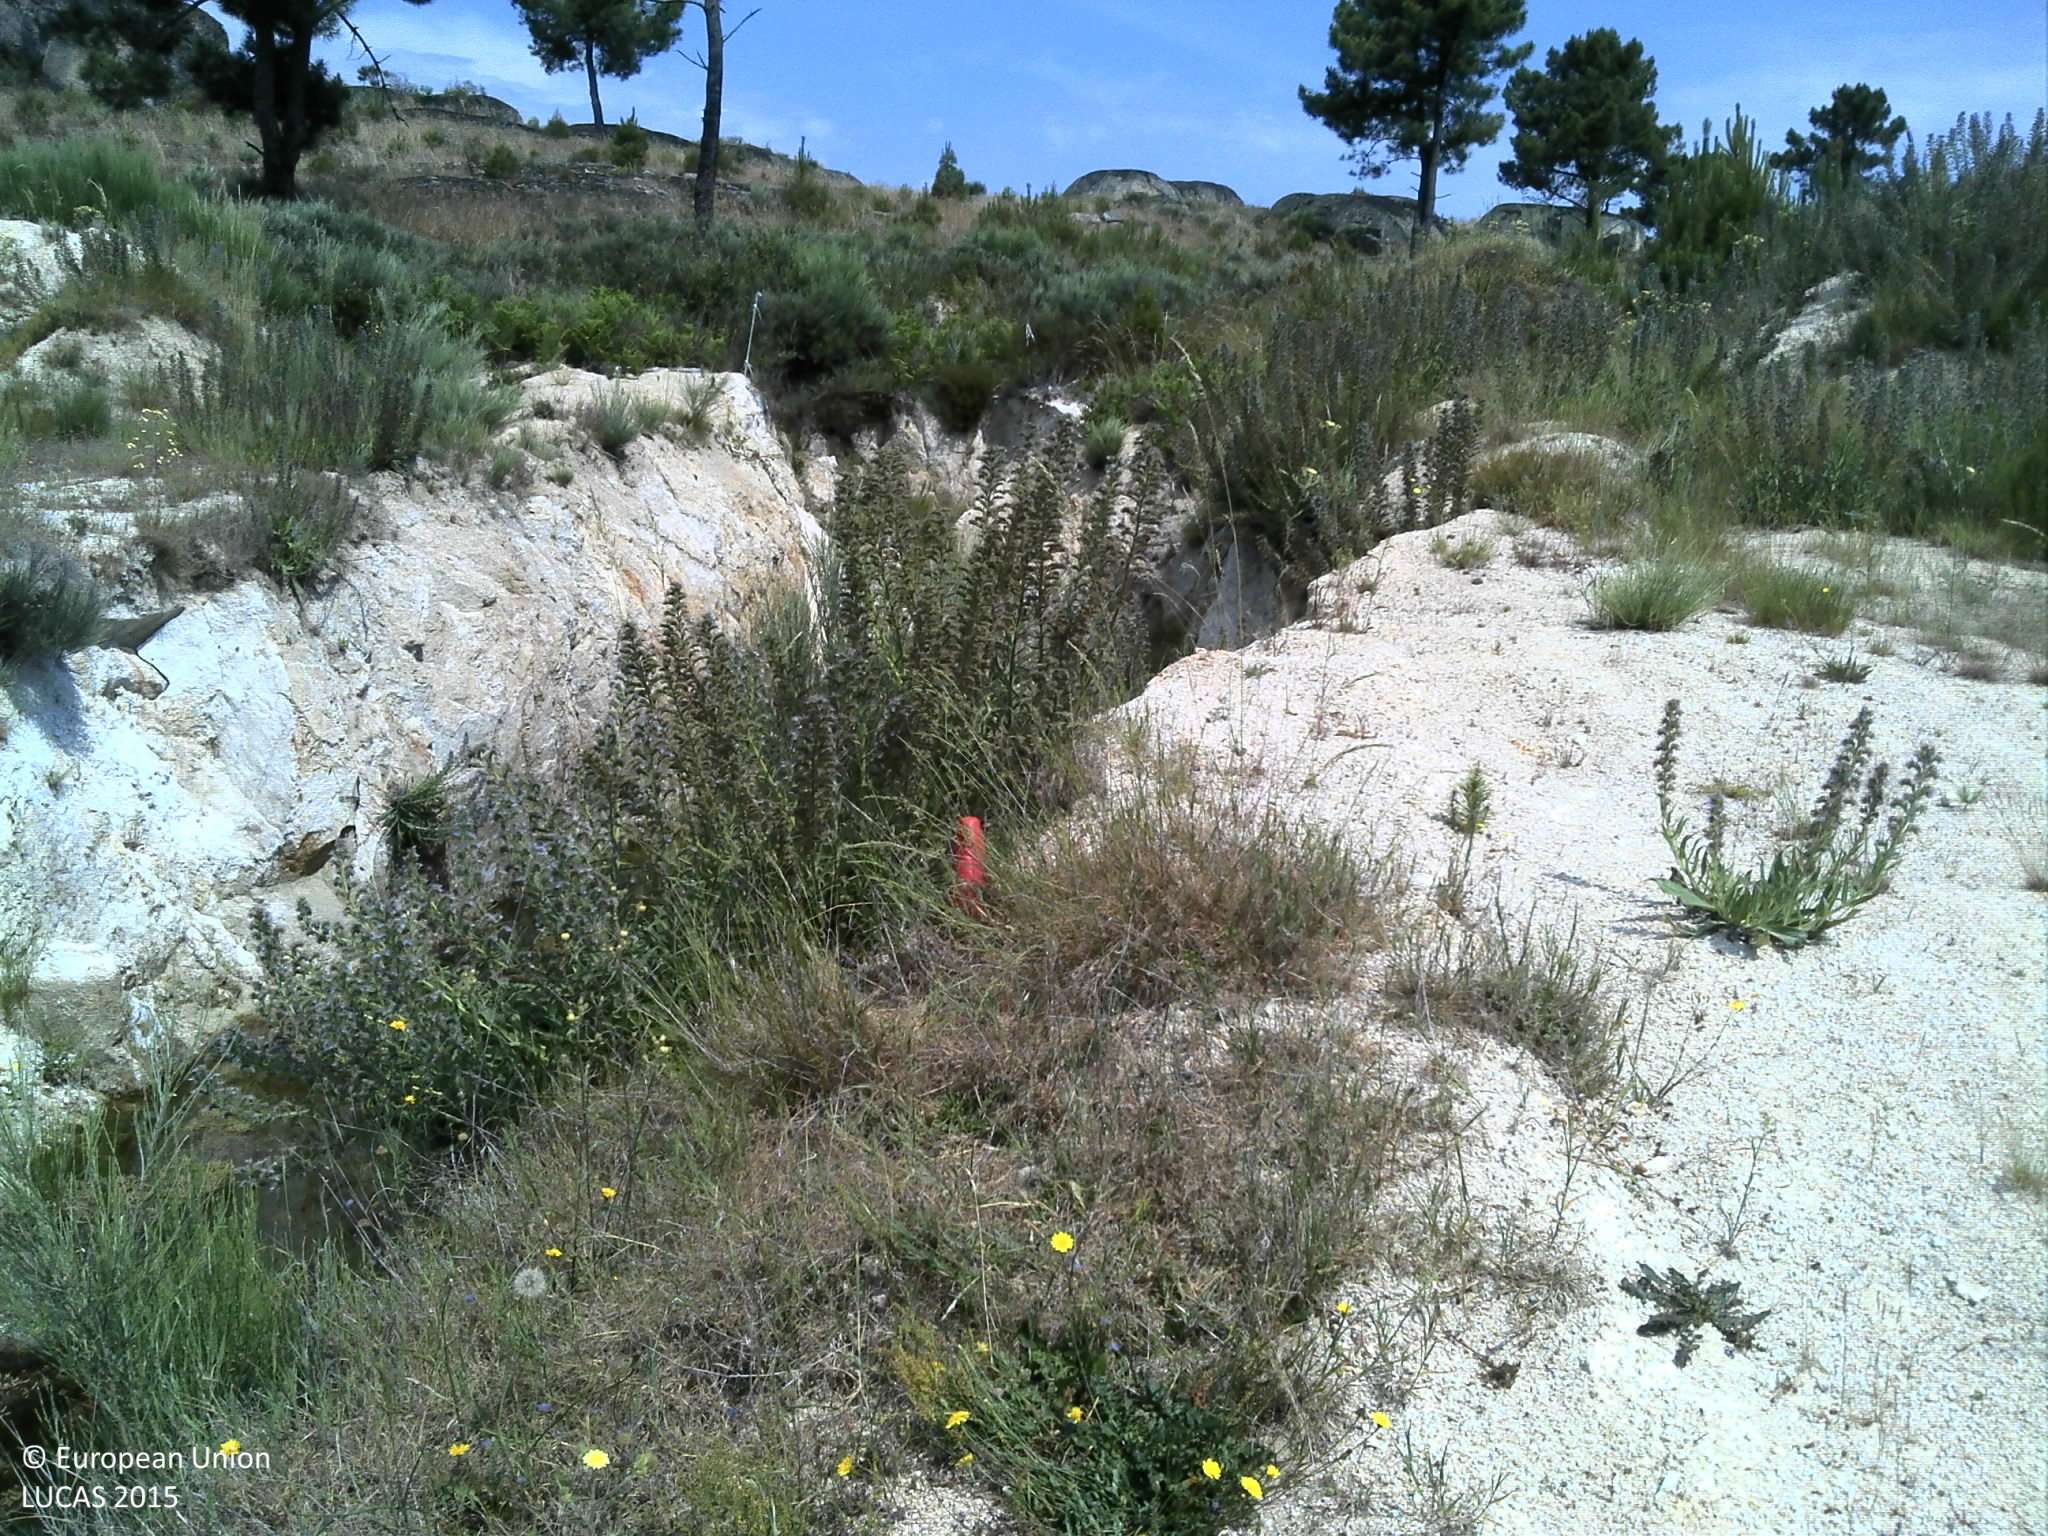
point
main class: Shrubland
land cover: Shrubland with sparse tree cover
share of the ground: 50 - 75 %
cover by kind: shrubs 70 %, unconsolidated bare surface 25 %, coniferous forest trees 5 %
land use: Semi-natural and natural areas not in use
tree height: > 5 m
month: June
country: PT
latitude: 41.4192
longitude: -7.5600
